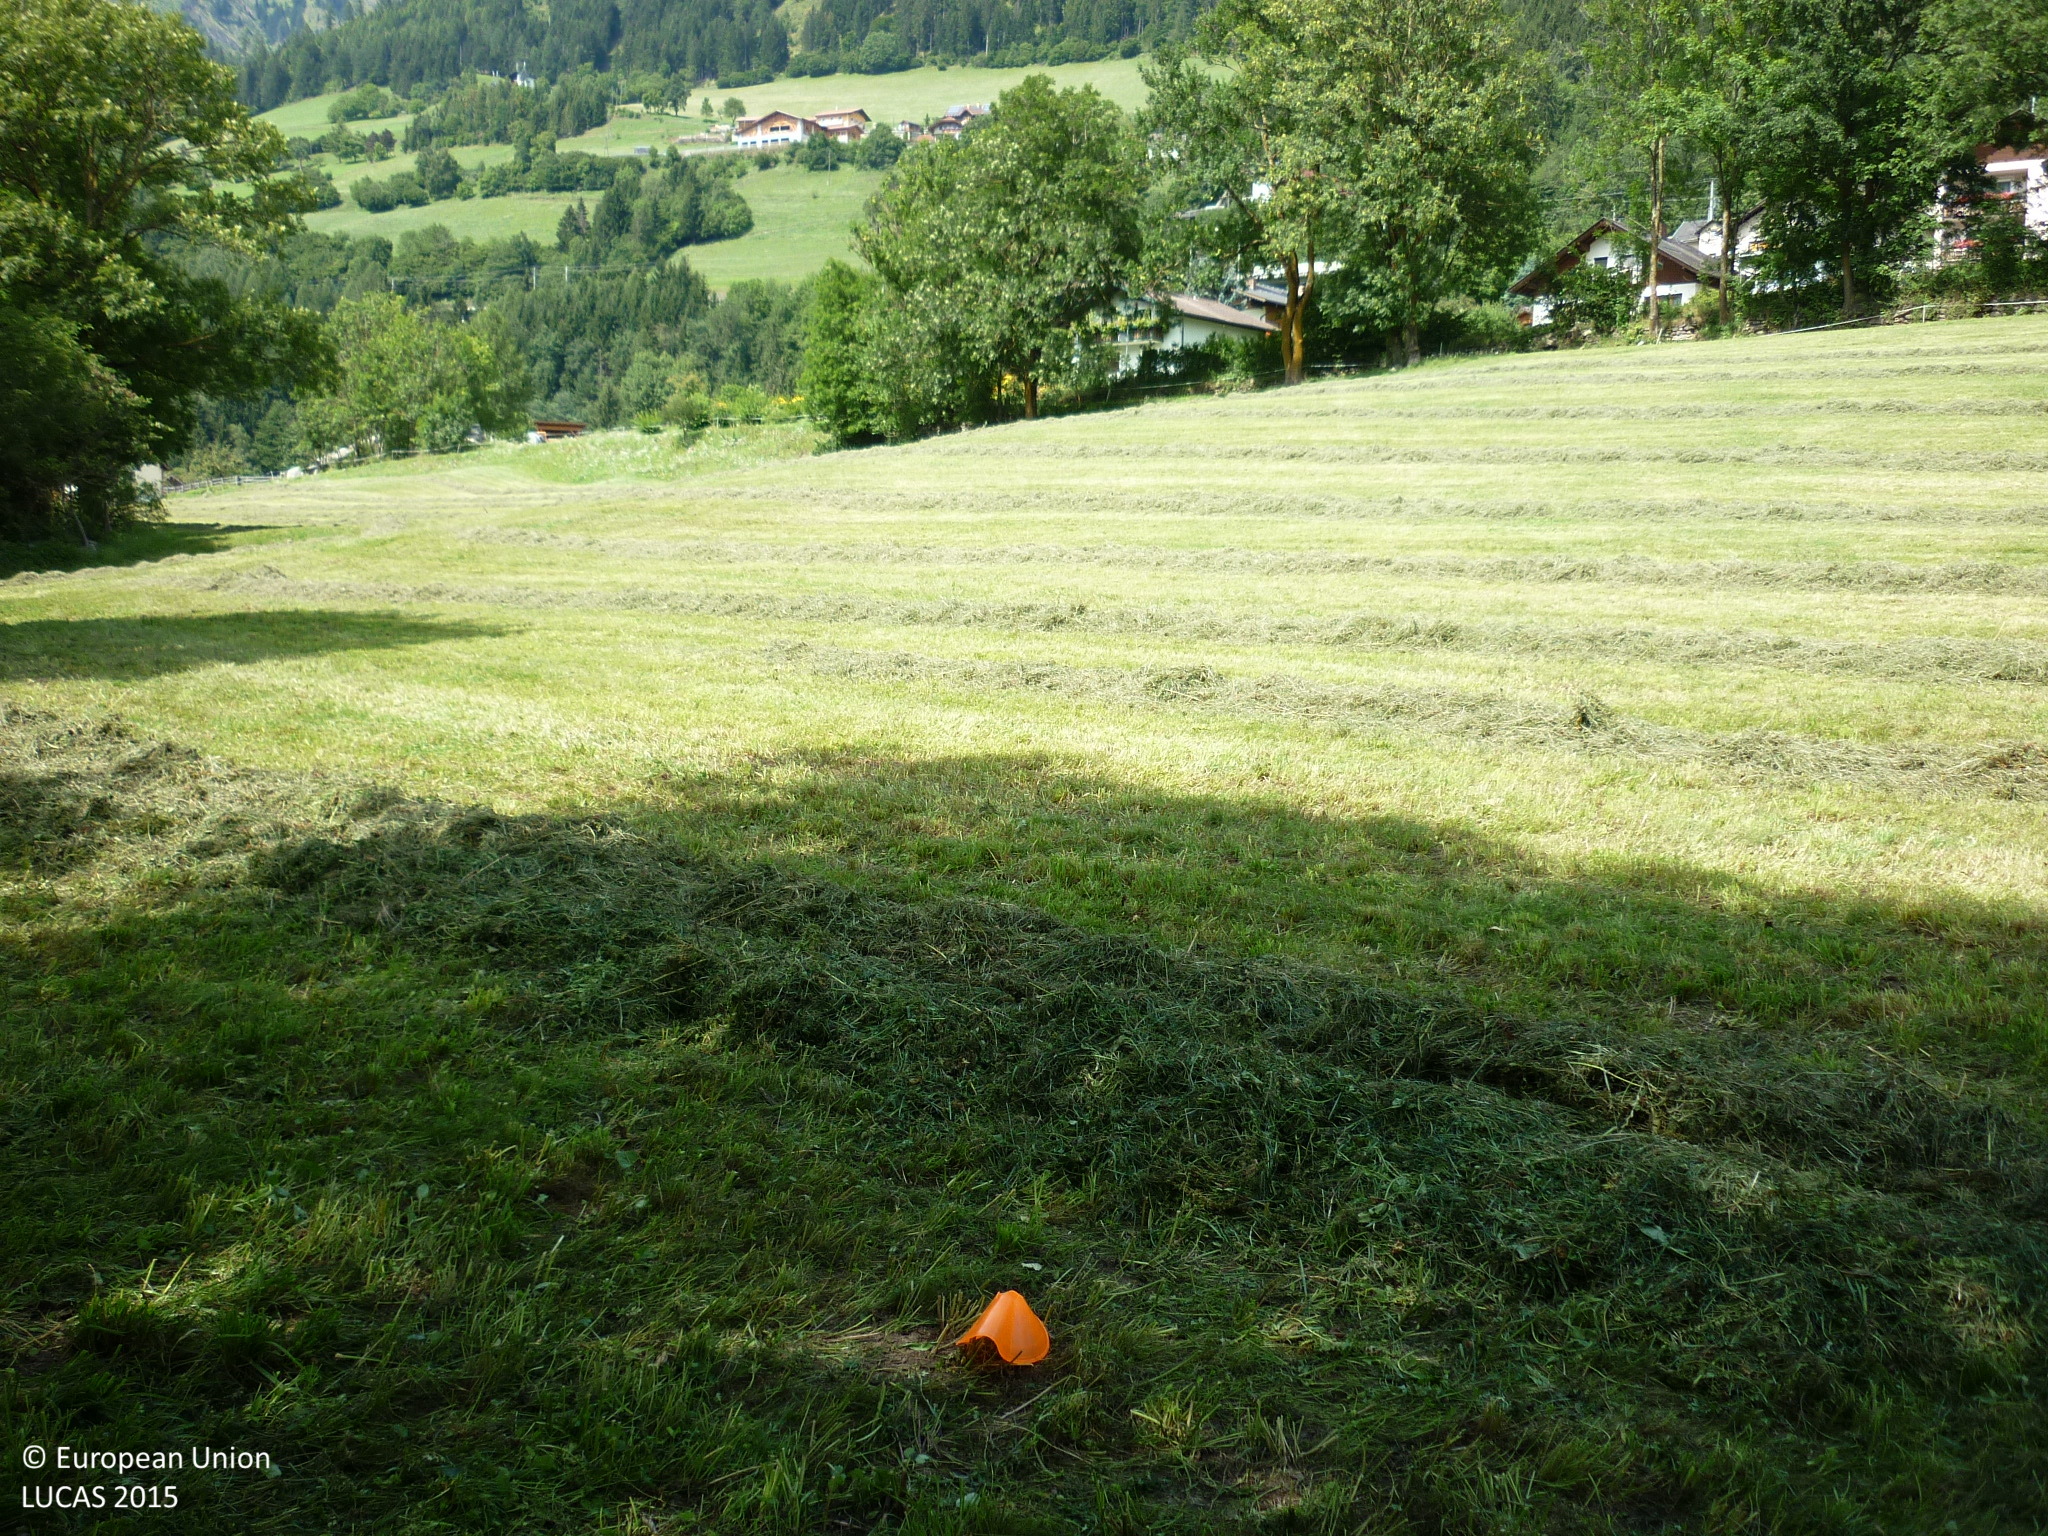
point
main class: Grassland
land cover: Grassland without tree/shrub cover
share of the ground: > 75 %
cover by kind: herbaceous plants 100 %
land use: Agriculture (excluding fallow land and kitchen gardens)
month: August
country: AT
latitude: 46.8766
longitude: 13.3171
